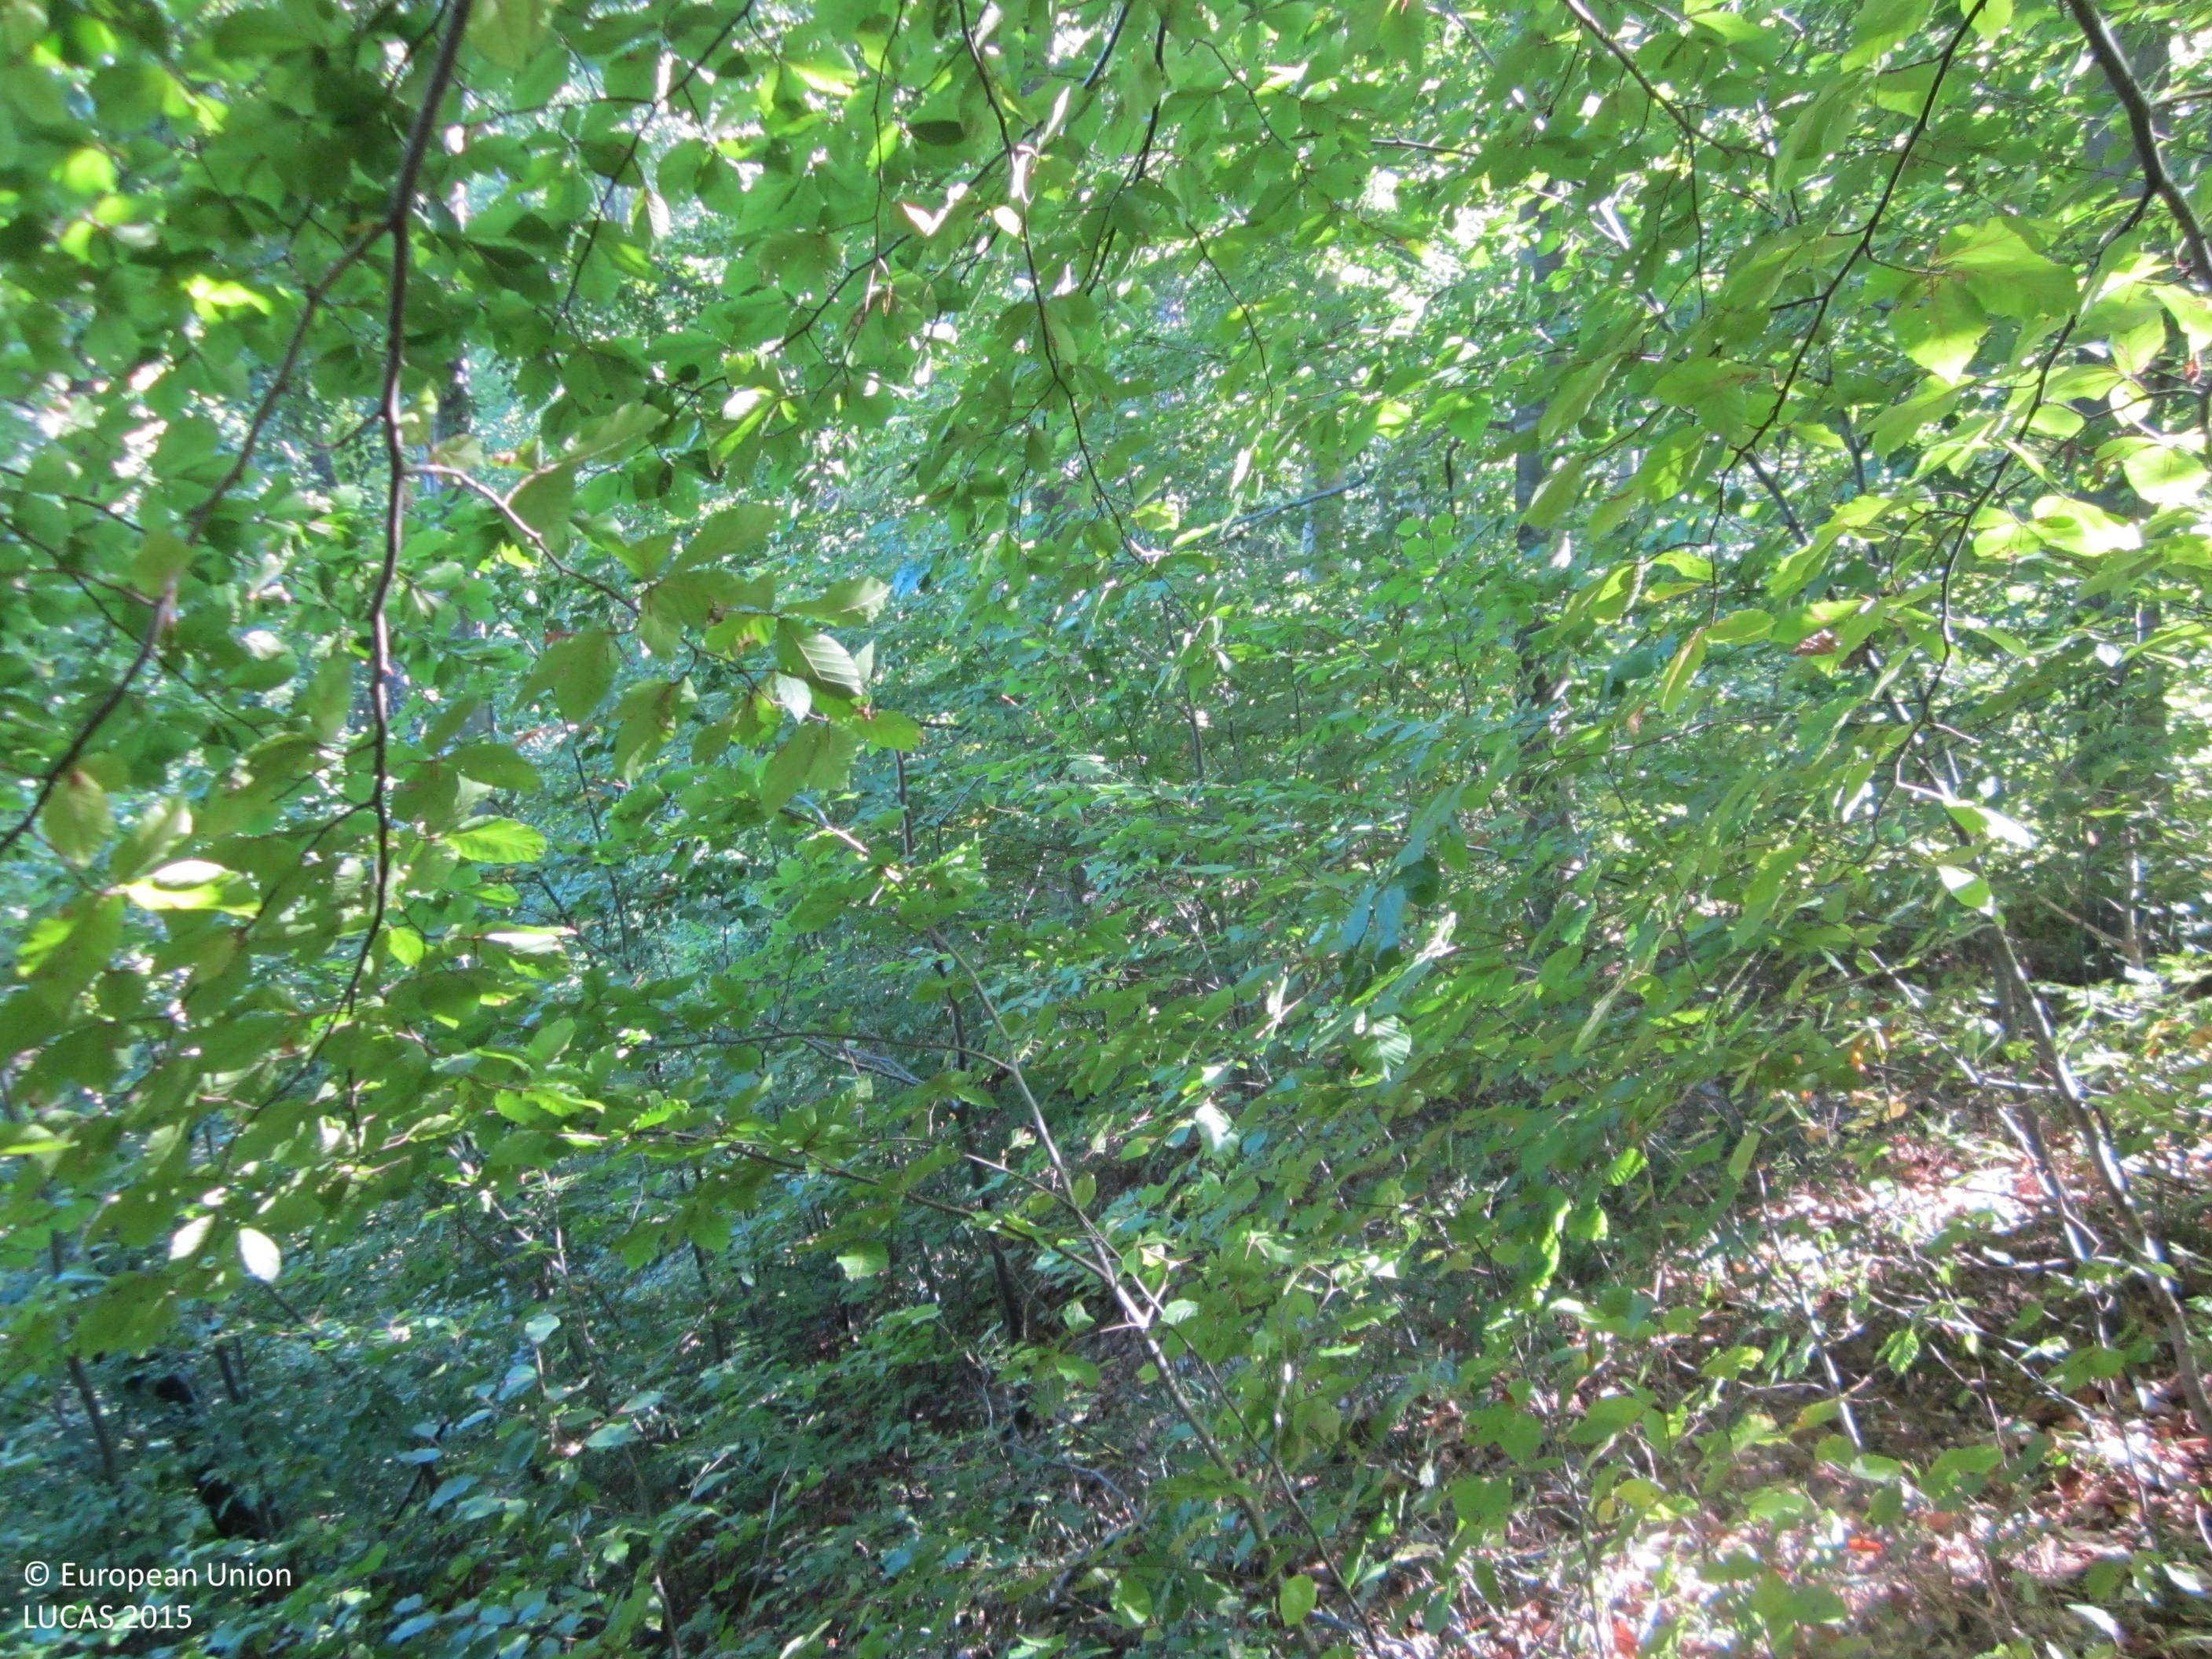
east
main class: Woodland
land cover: Broadleaved woodland
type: hemiboreal forest and nemoral coniferous forest and mixed broadleaved-coniferous forest
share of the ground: > 75 %
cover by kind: broadleaved forest trees 80 %, unconsolidated bare surface 10 %, shrubs 5 %, herbaceous plants 5 %
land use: Forestry
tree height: > 5 m
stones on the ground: < 10 %
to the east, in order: Broadleaved woodland; Rivers and streams; Broadleaved woodland; Paved roads, cycling and walking lanes; Broadleaved woodland; Tracks; Broadleaved woodland
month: October
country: BG
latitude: 42.9415
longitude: 26.6333
